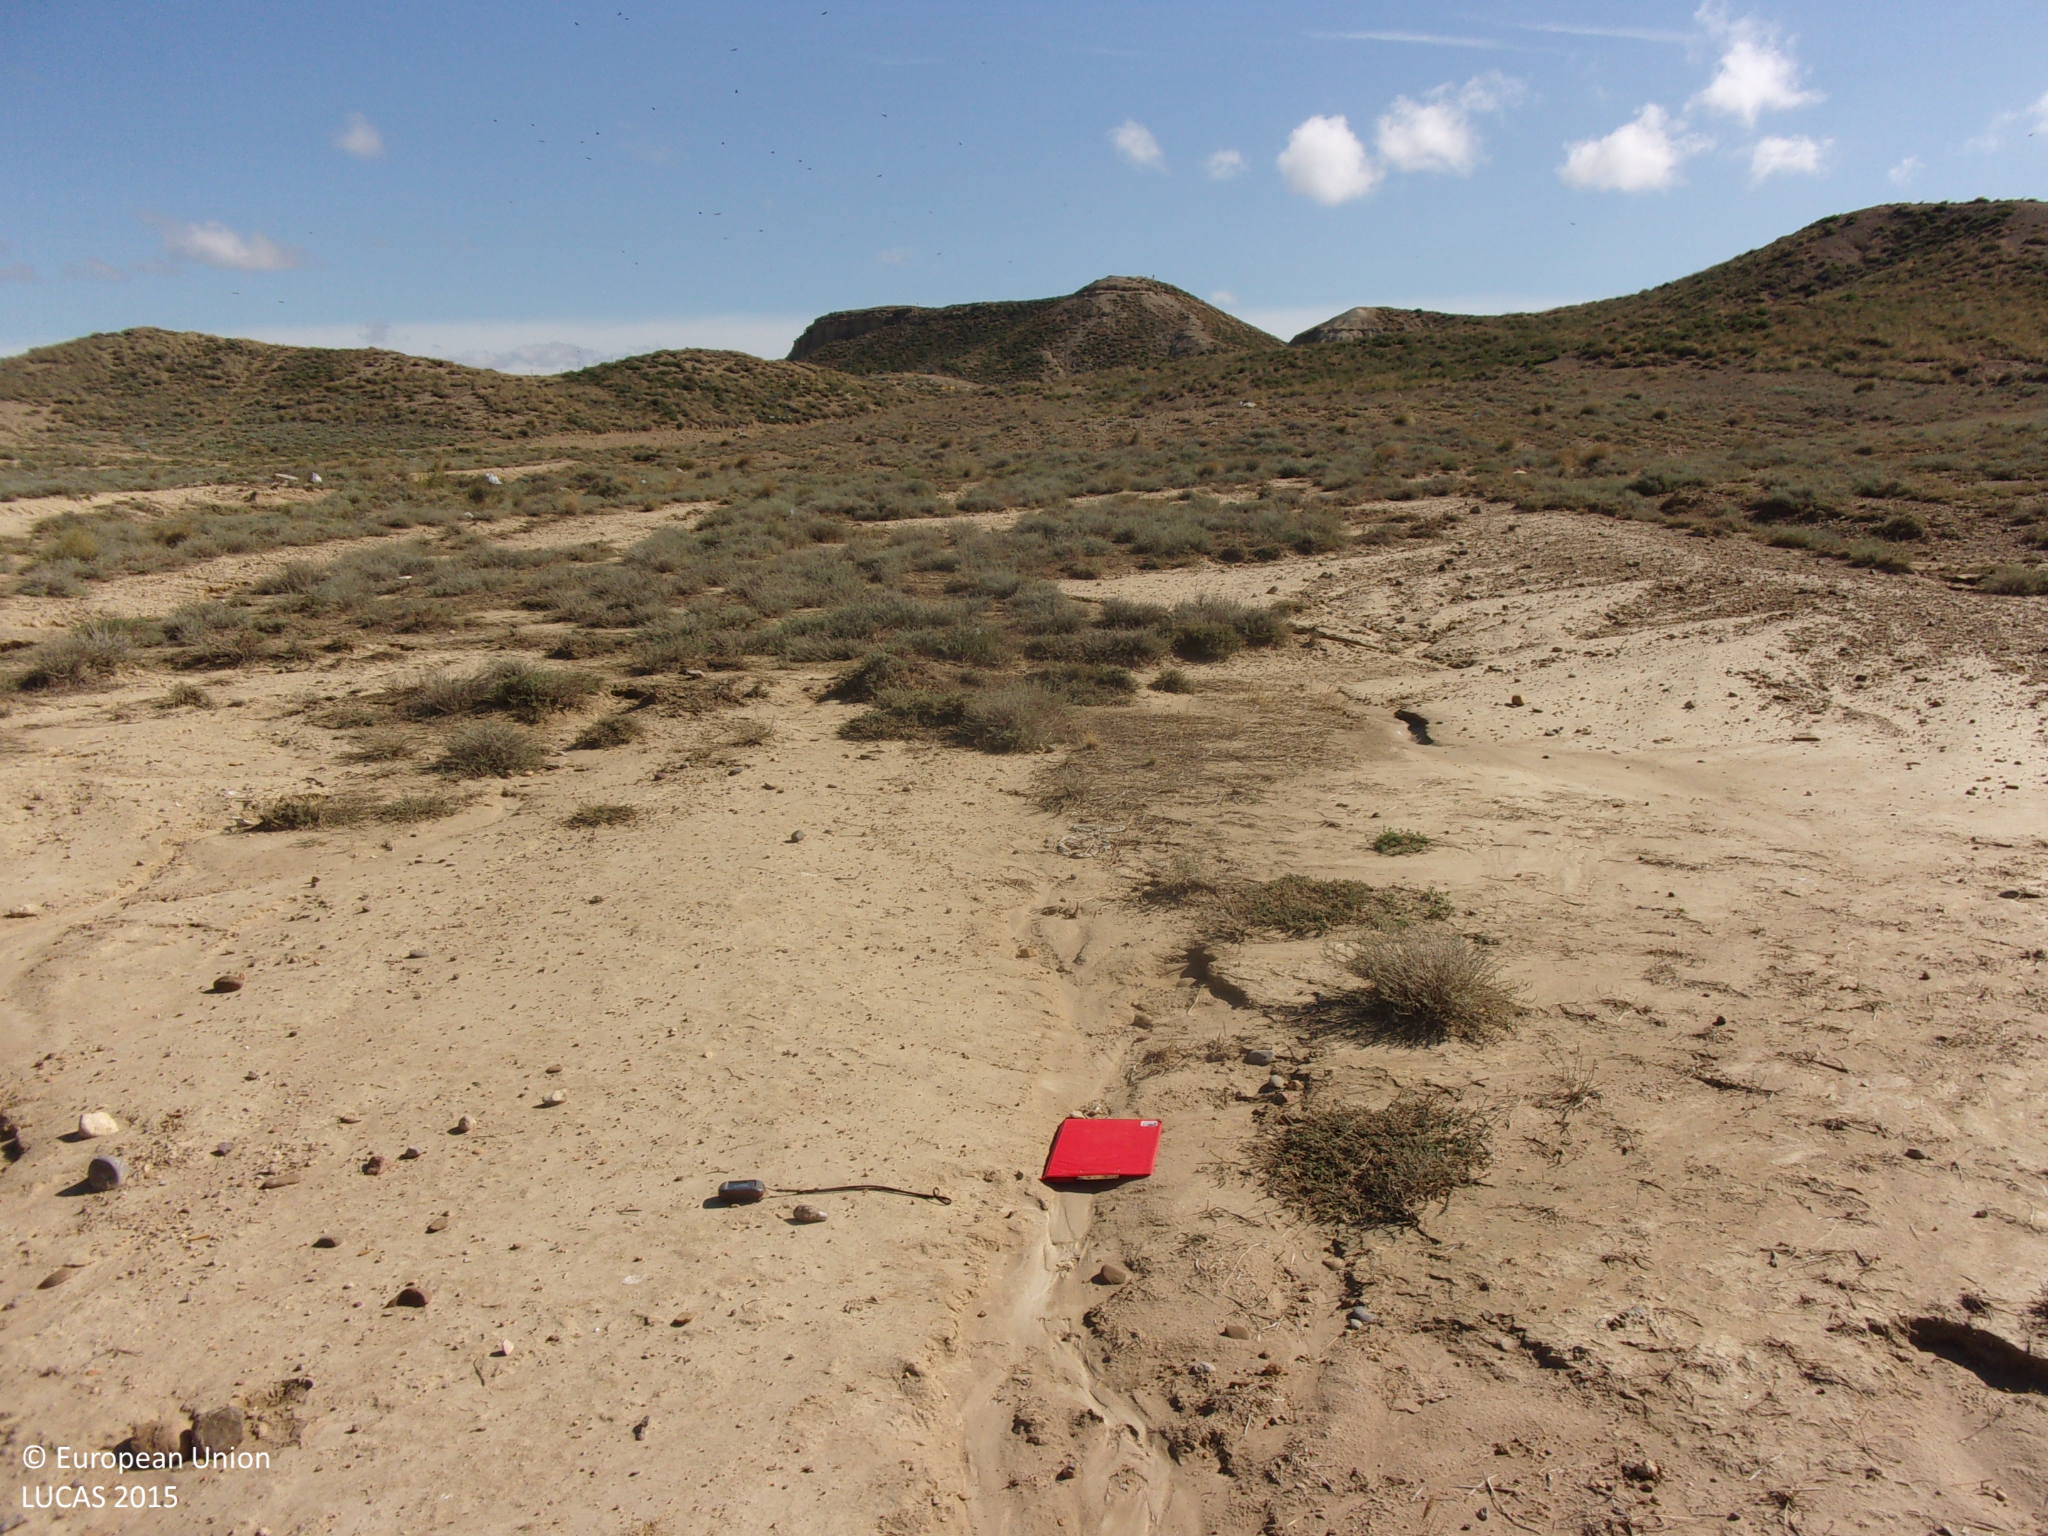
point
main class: Shrubland
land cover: Shrubland without tree cover
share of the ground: 10 - 25 %
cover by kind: consolidated bare surface 90 %, shrubs 10 %
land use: Abandoned areas
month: August
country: ES
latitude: 42.0923
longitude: -1.1388
